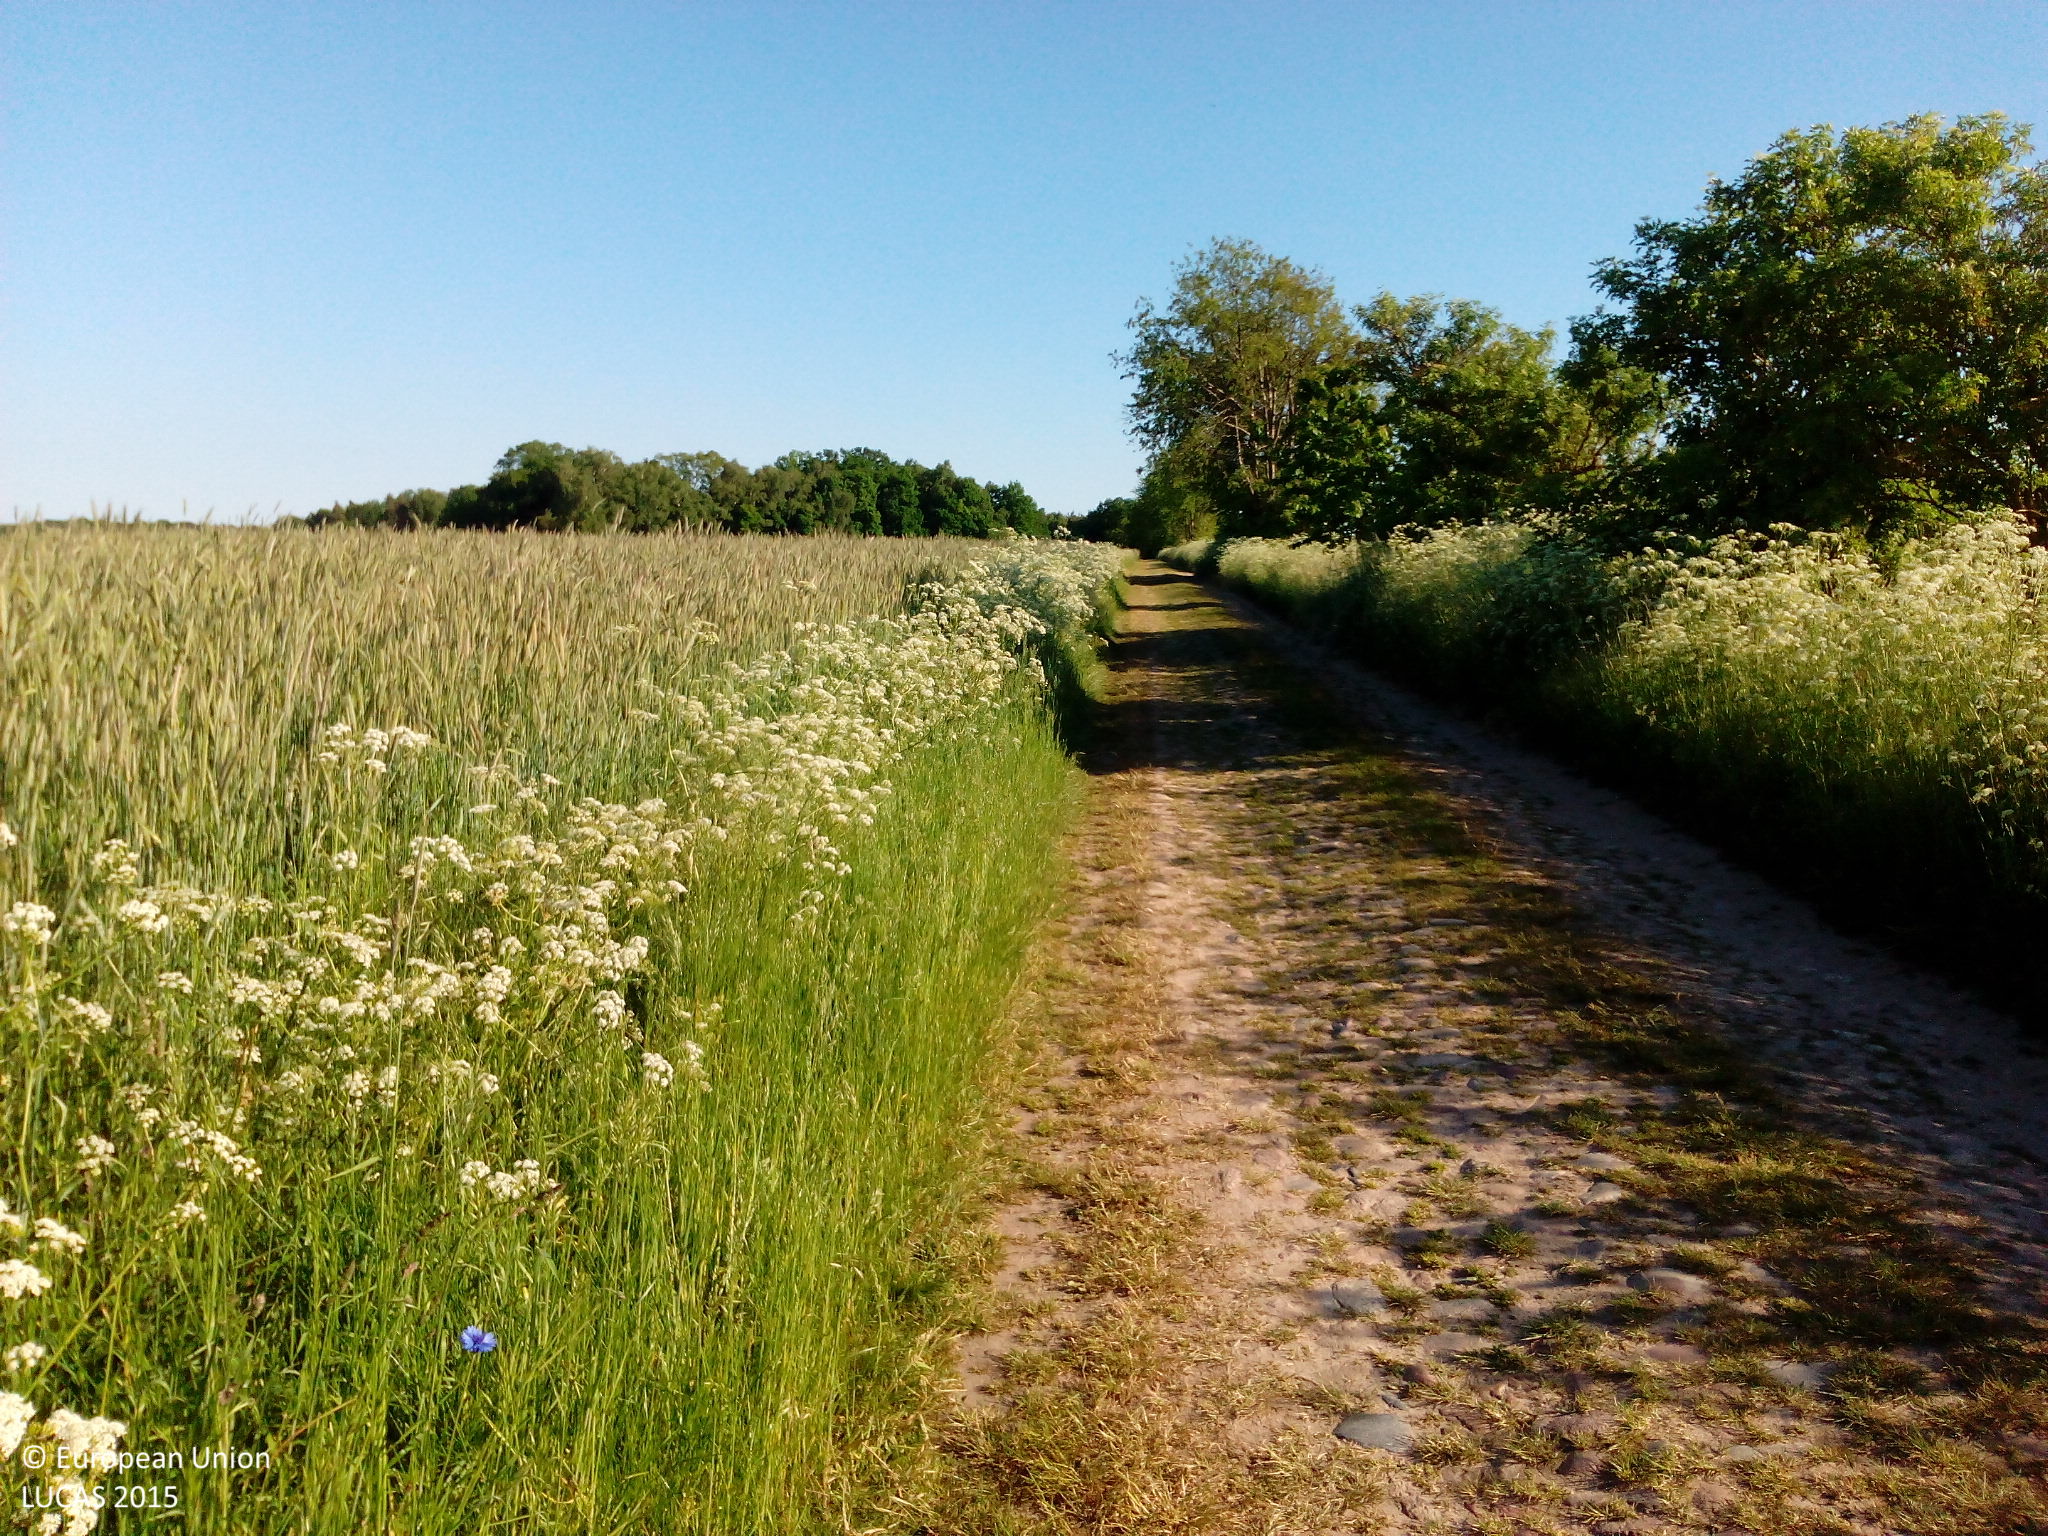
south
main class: Cropland
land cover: Rye
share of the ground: > 75 %
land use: Agriculture (excluding fallow land and kitchen gardens)
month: June
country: DE
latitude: 53.2712
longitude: 12.3535
